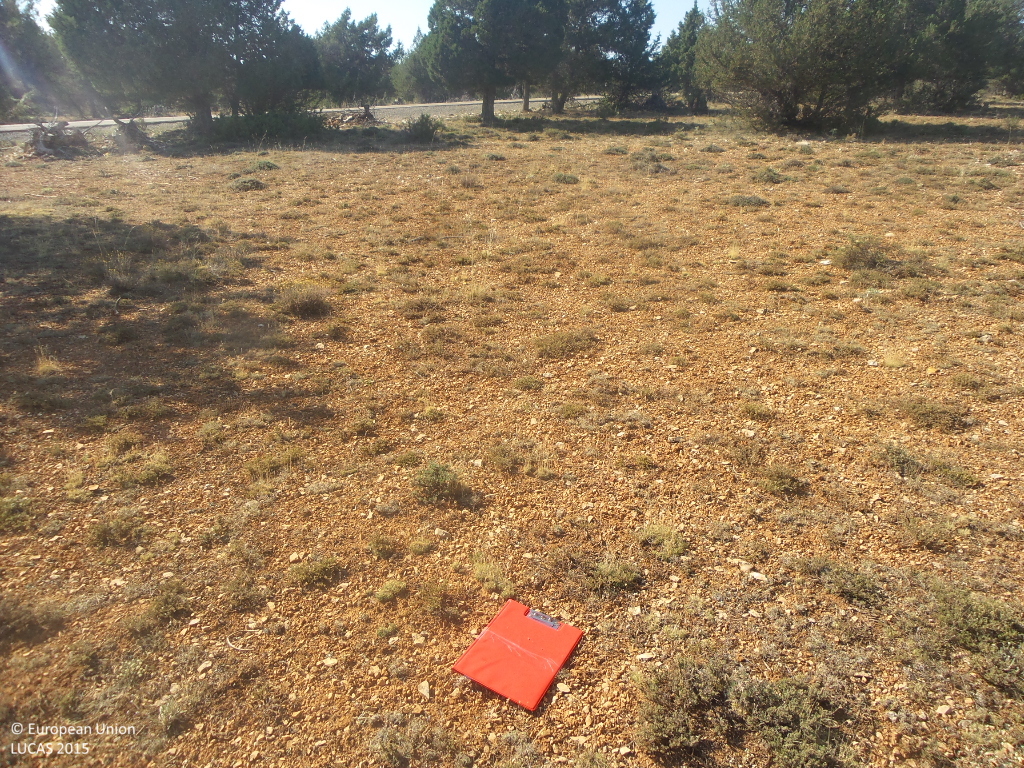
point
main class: Woodland
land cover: Other coniferous woodland
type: coniferous forest of the mediterranean region
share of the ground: 10 - 25 %
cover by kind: unconsolidated bare surface 55 %, coniferous forest trees 20 %, shrubs 20 %, herbaceous plants 5 %
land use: Semi-natural and natural areas not in use
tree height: > 5 m
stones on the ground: < 10 %
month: July
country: ES
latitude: 41.0823
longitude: -2.1328
